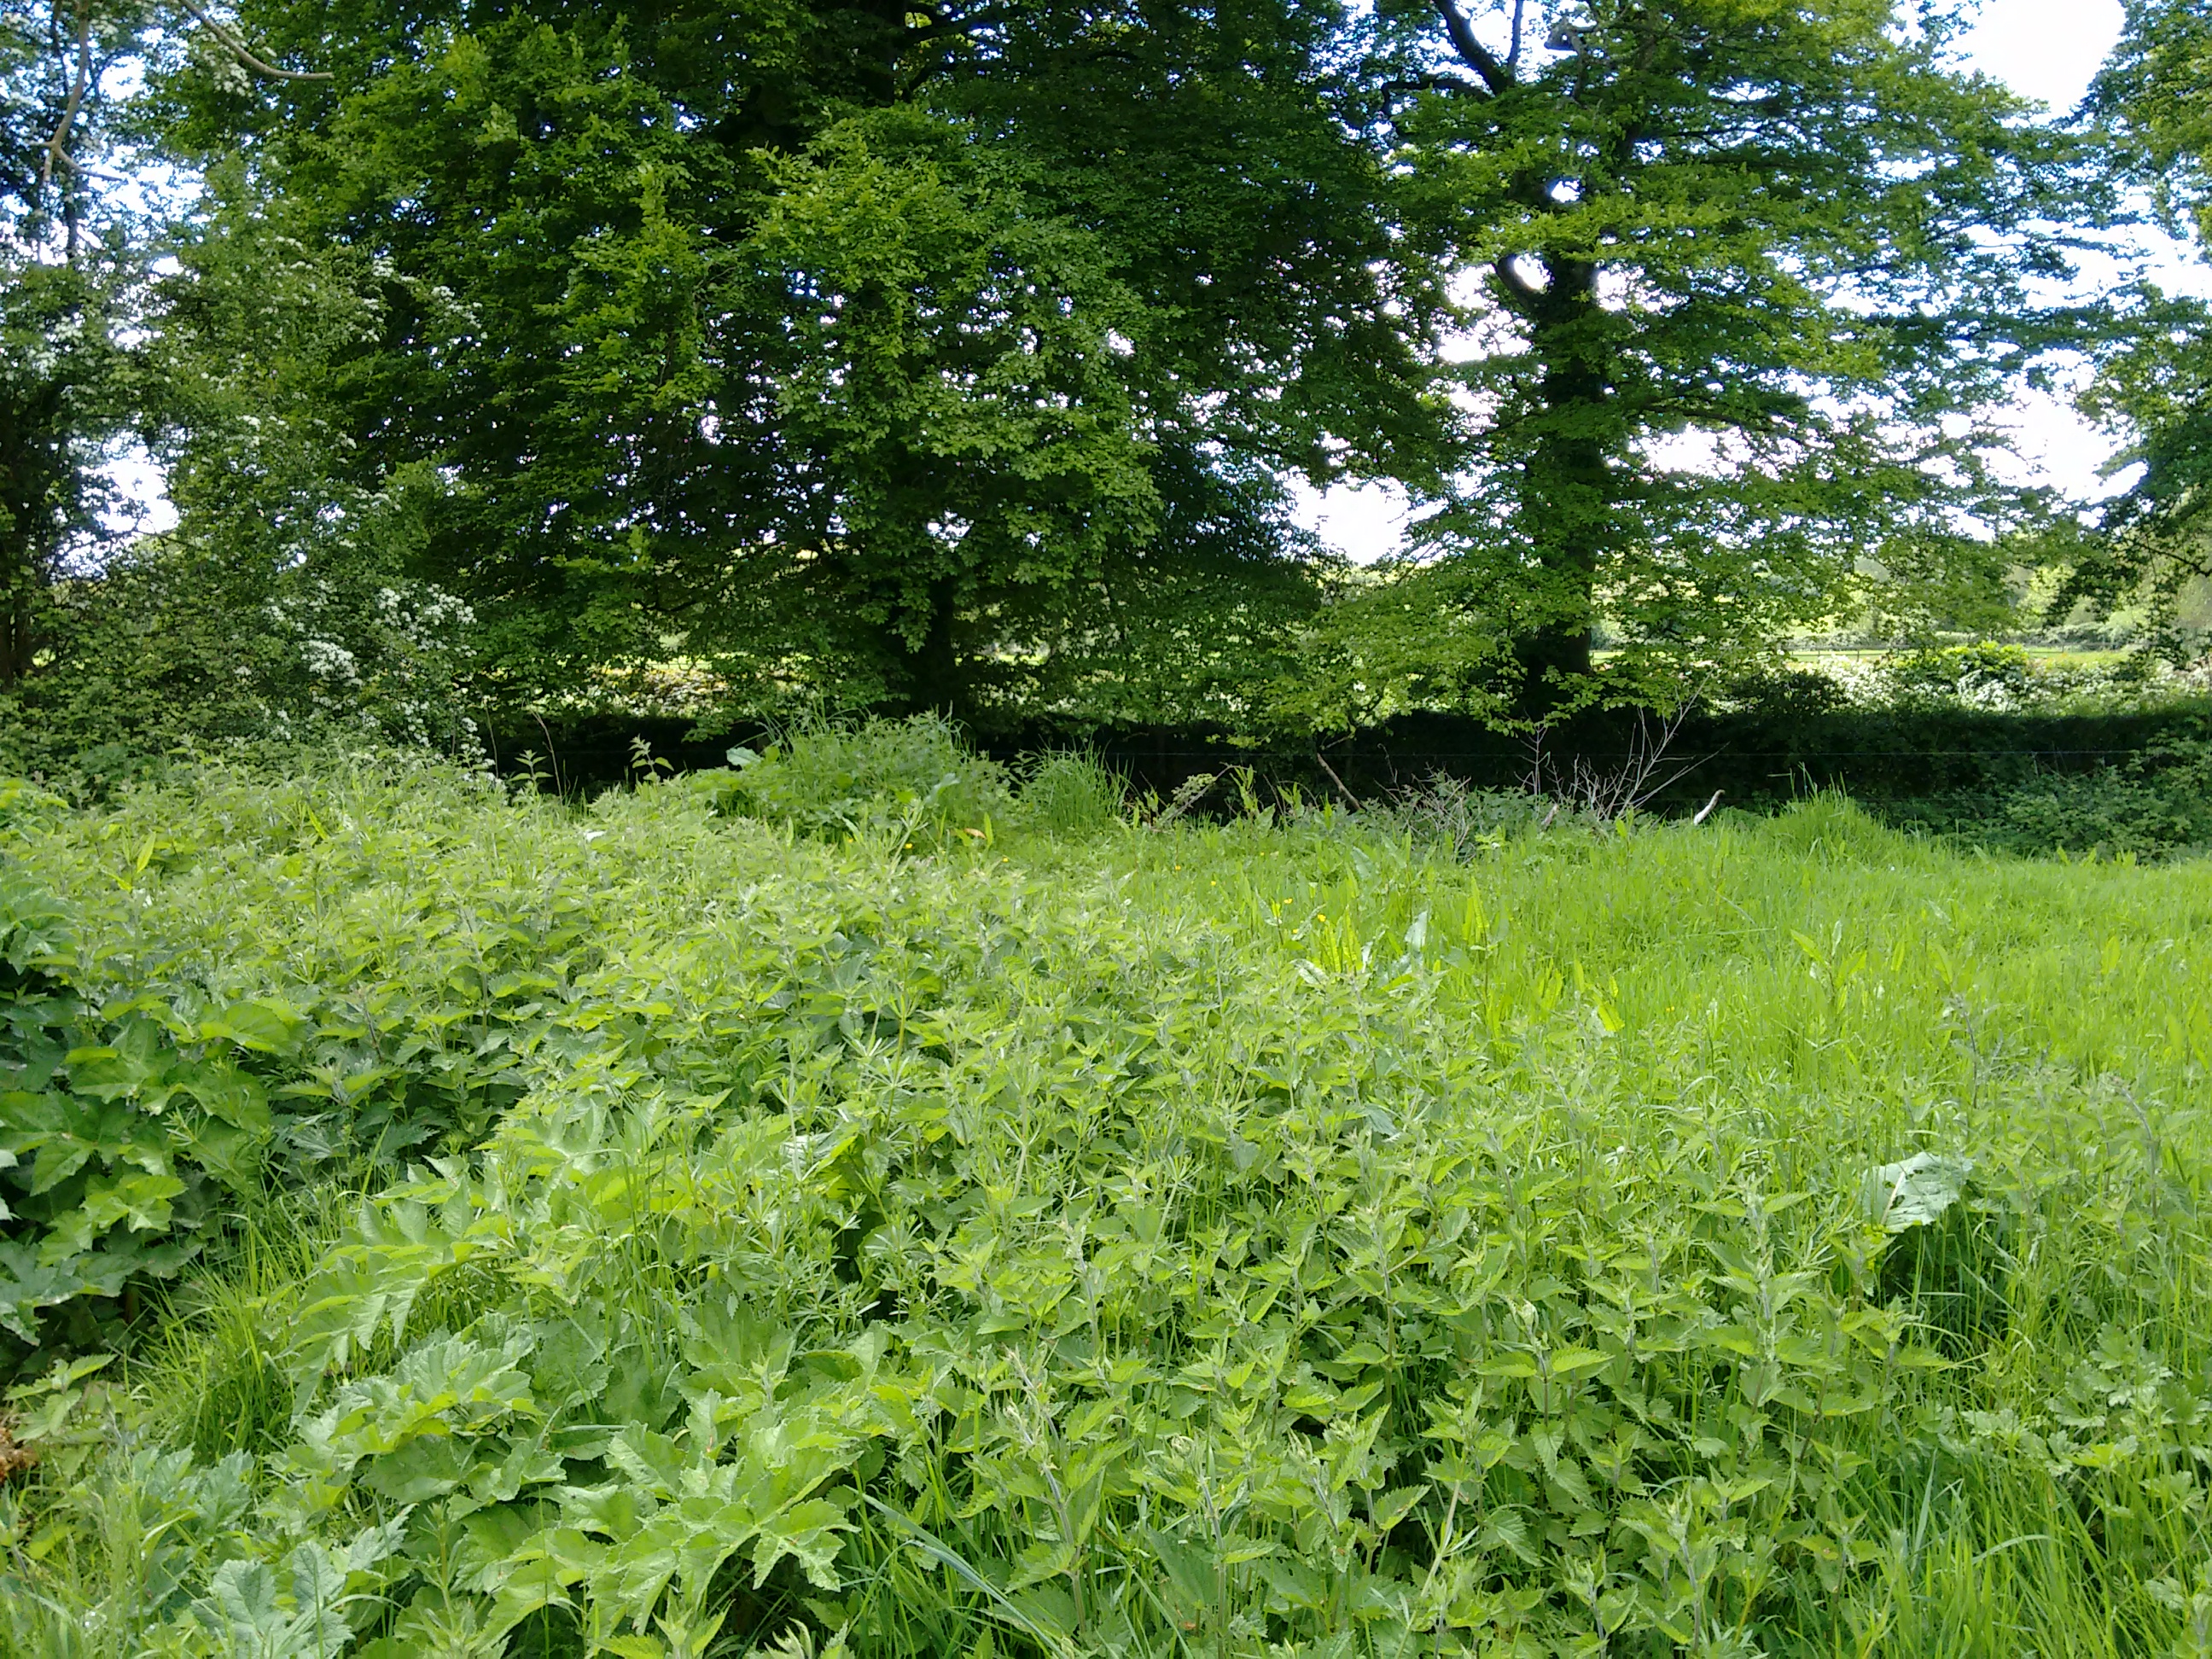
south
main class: Grassland
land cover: Grassland with sparse tree/shrub cover
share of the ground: > 75 %
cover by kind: herbaceous plants 90 %, broadleaved forest trees 5 %, shrubs 5 %
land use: Agriculture (excluding fallow land and kitchen gardens)
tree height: > 5 m
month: May
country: IE
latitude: 53.6125
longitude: -6.8081
